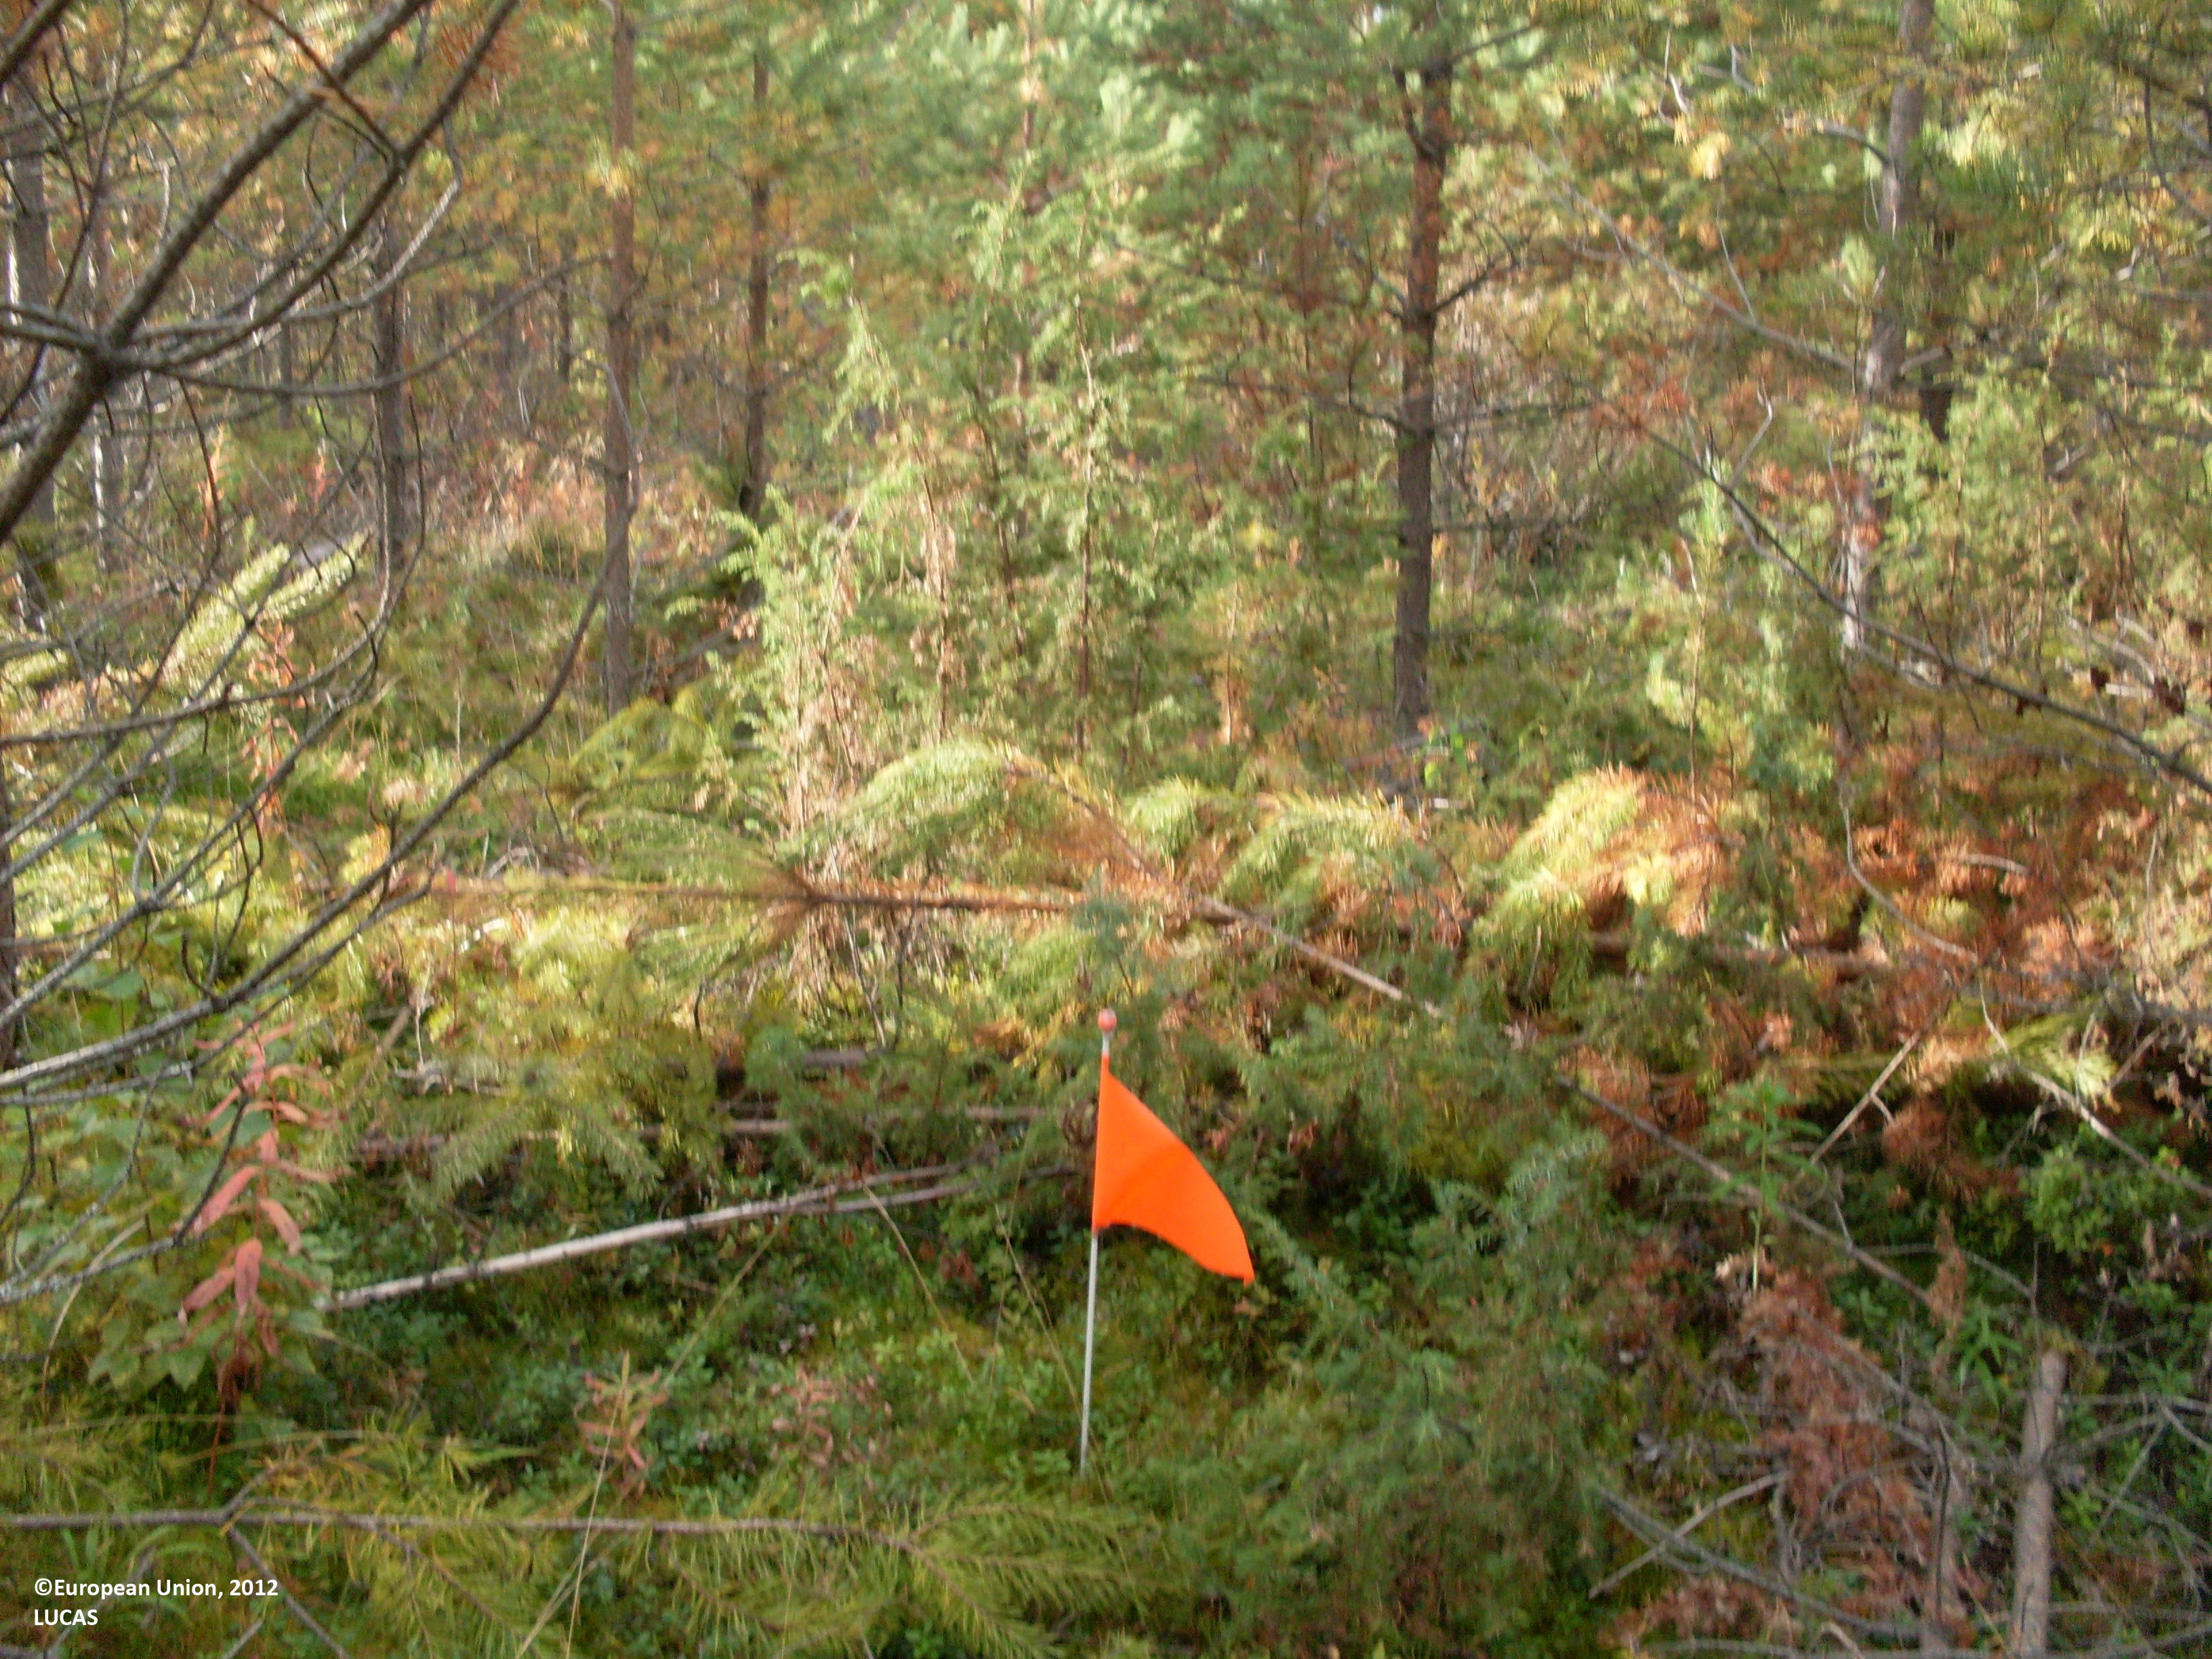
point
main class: Woodland
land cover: Pine dominated coniferous woodland
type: boreal forest
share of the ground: > 75 %
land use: Forestry
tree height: > 5 m
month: September
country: FI
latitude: 64.1234
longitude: 28.4358
